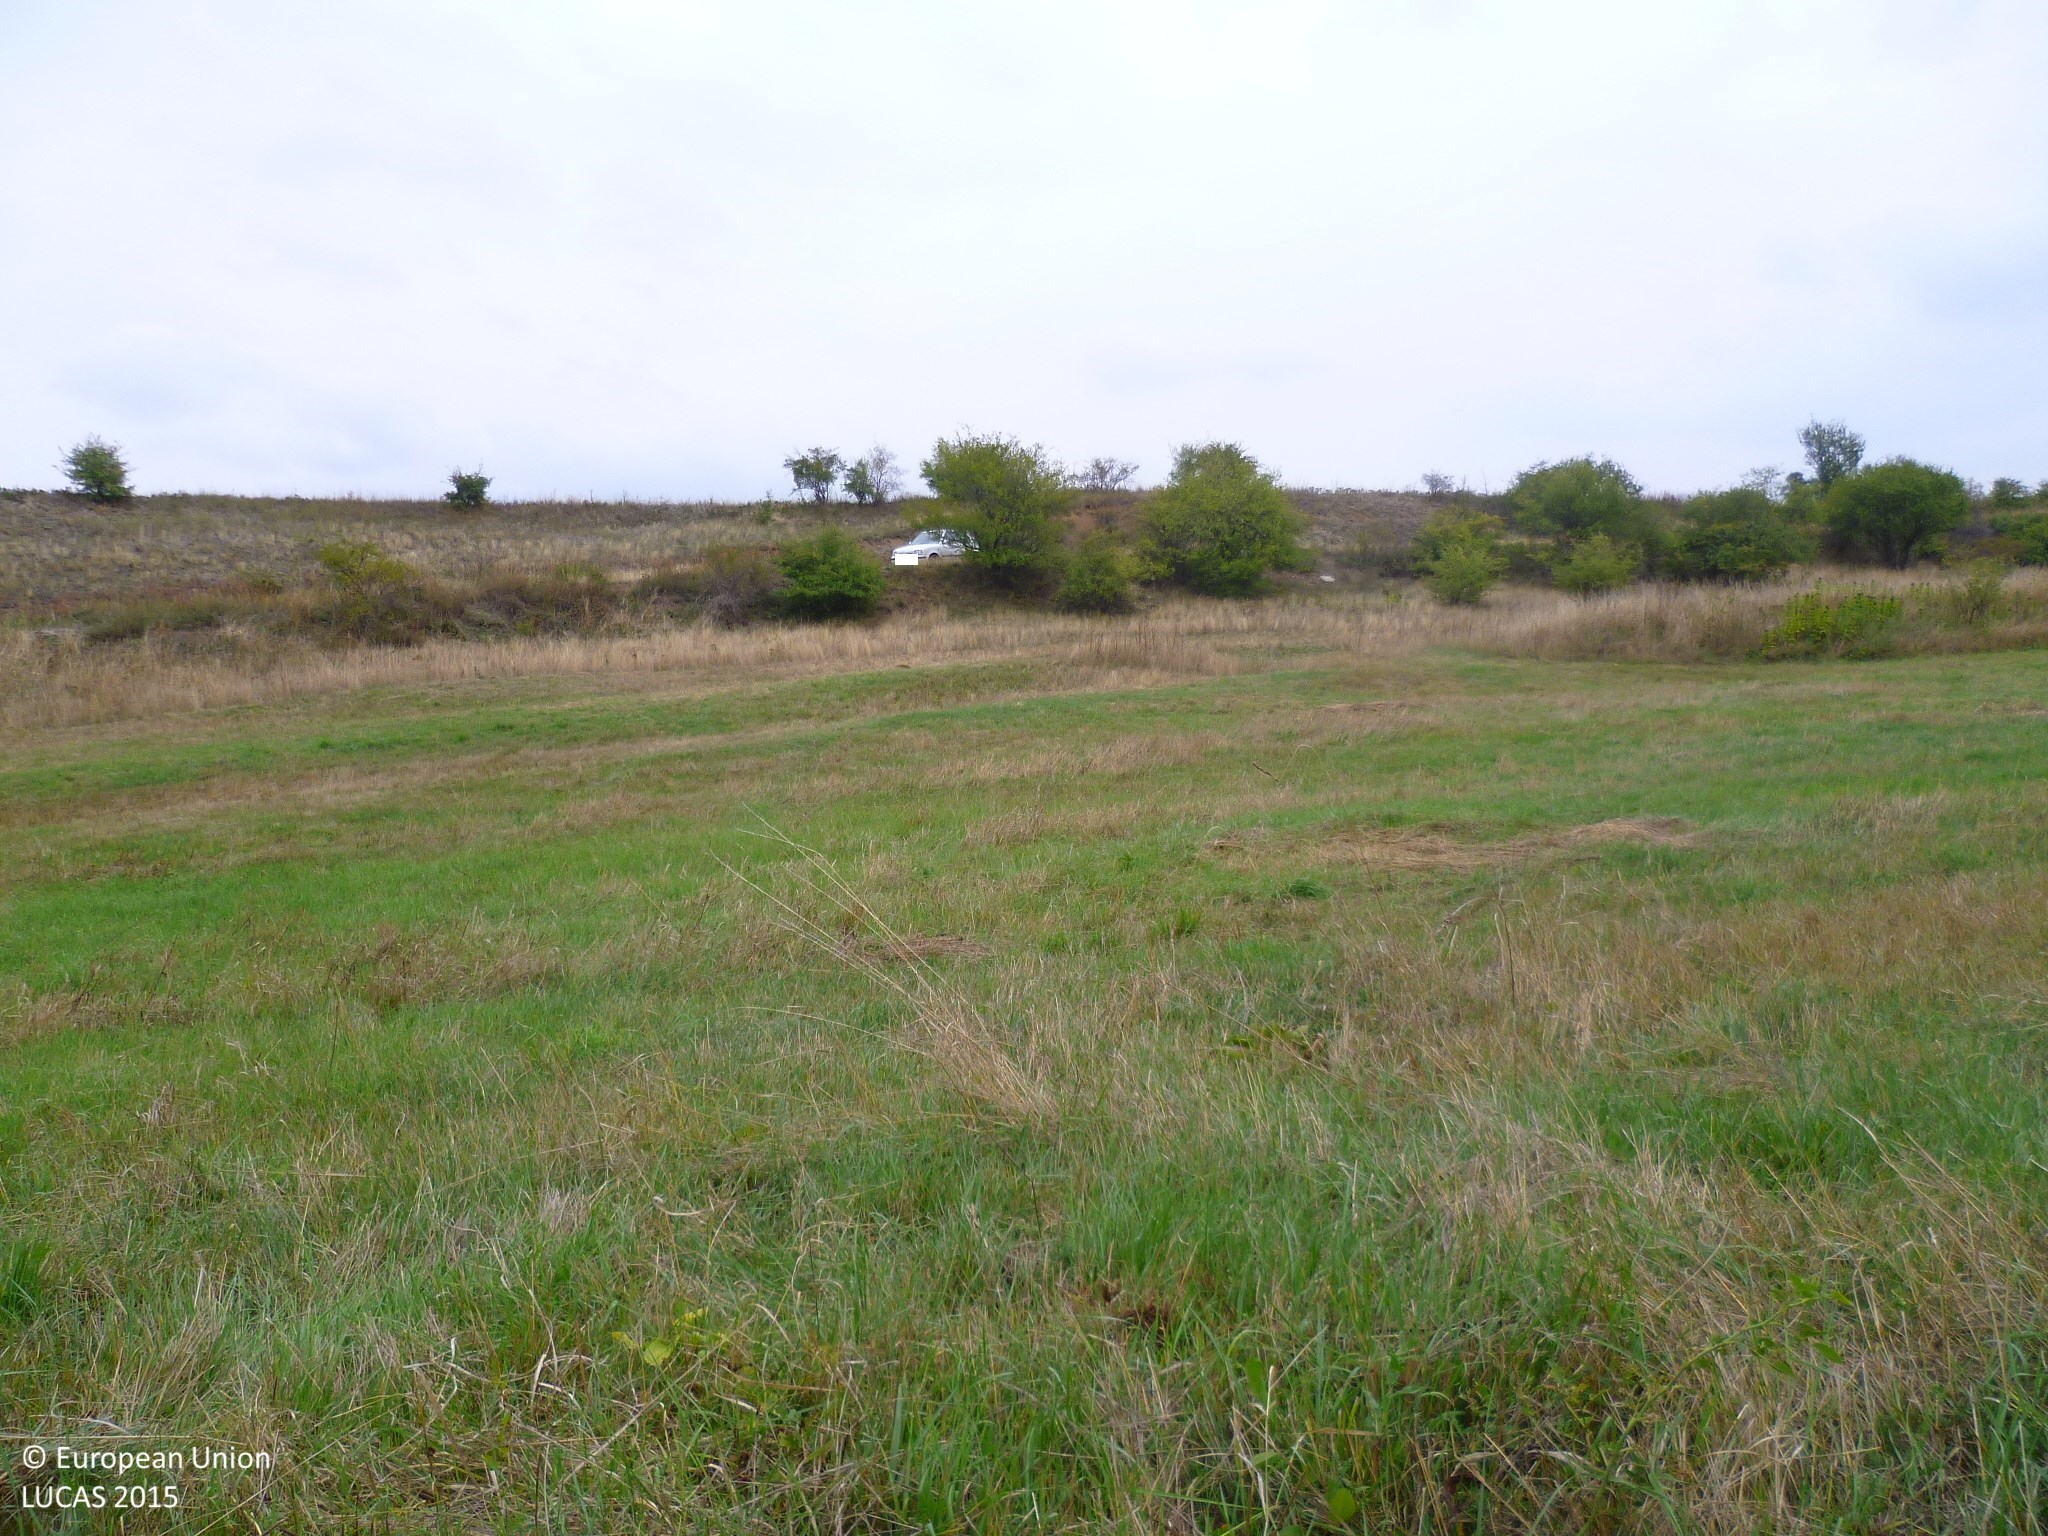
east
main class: Grassland
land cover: Grassland without tree/shrub cover
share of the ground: > 75 %
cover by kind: herbaceous plants 100 %
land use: Agriculture (excluding fallow land and kitchen gardens)
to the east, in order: Grassland without tree/shrub cover; Grassland with sparse tree/shrub cover; Paved roads, cycling and walking lanes; Grassland with sparse tree/shrub cover; Barley; Shrubland with sparse tree cover; Broadleaved woodland
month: September
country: BG
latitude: 42.7658
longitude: 22.9715
